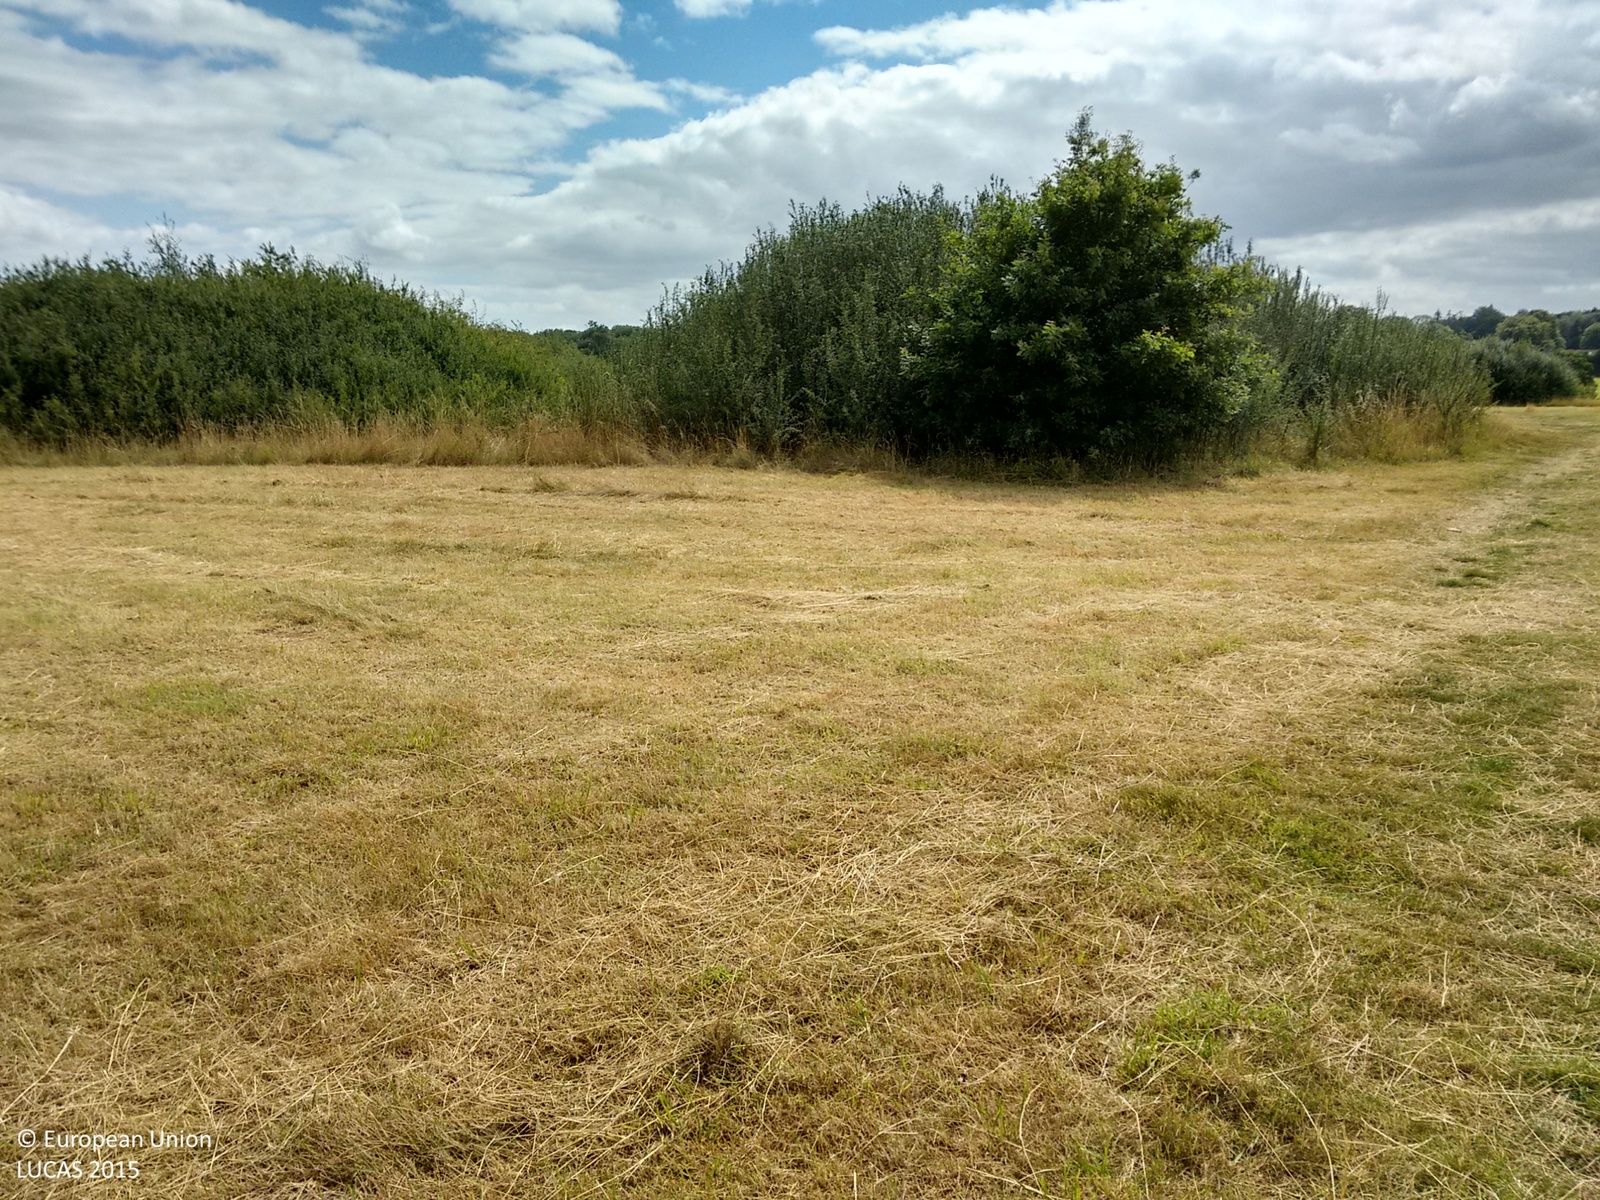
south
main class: Grassland
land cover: Grassland without tree/shrub cover
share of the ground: > 75 %
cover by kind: herbaceous plants 100 %
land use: Amenities, museums, leisure
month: August
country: GB
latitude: 51.3225
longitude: -0.1800
